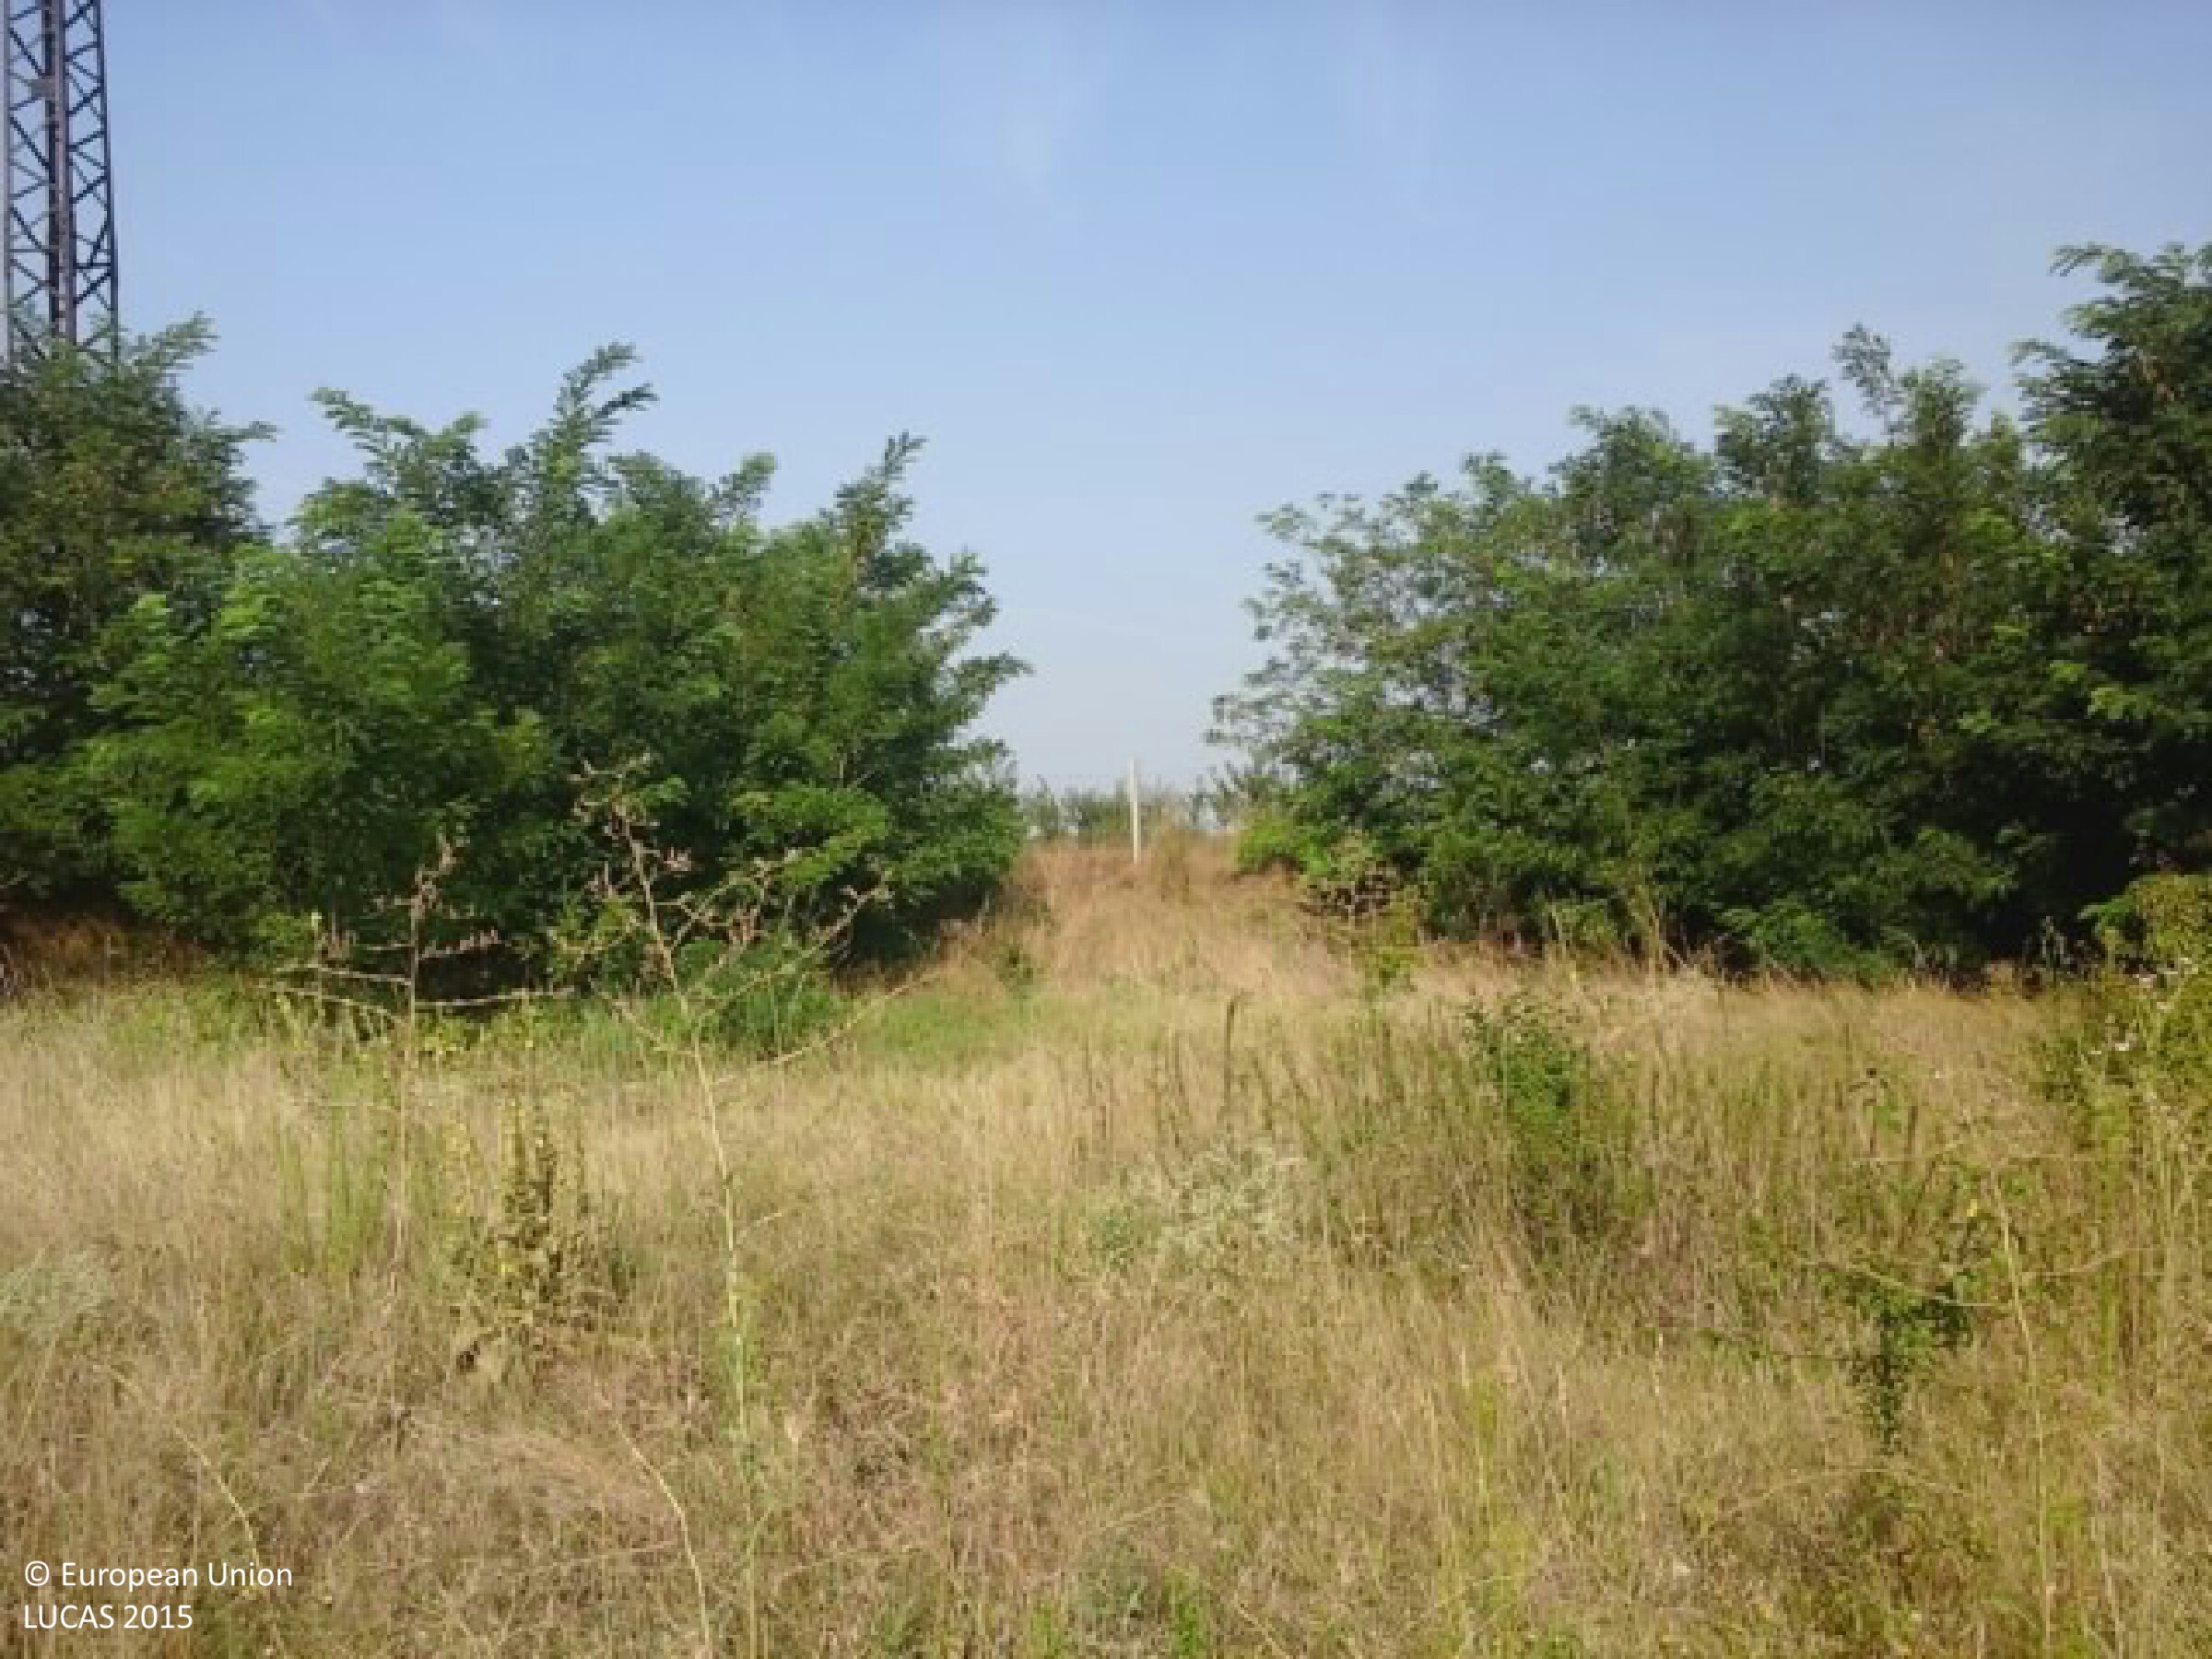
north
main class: Cropland
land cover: Cherry fruit
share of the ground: 50 - 75 %
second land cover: Other bare soil
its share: > 75 %
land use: Agriculture (excluding fallow land and kitchen gardens)
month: July
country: HU
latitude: 47.5988
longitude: 20.2567
